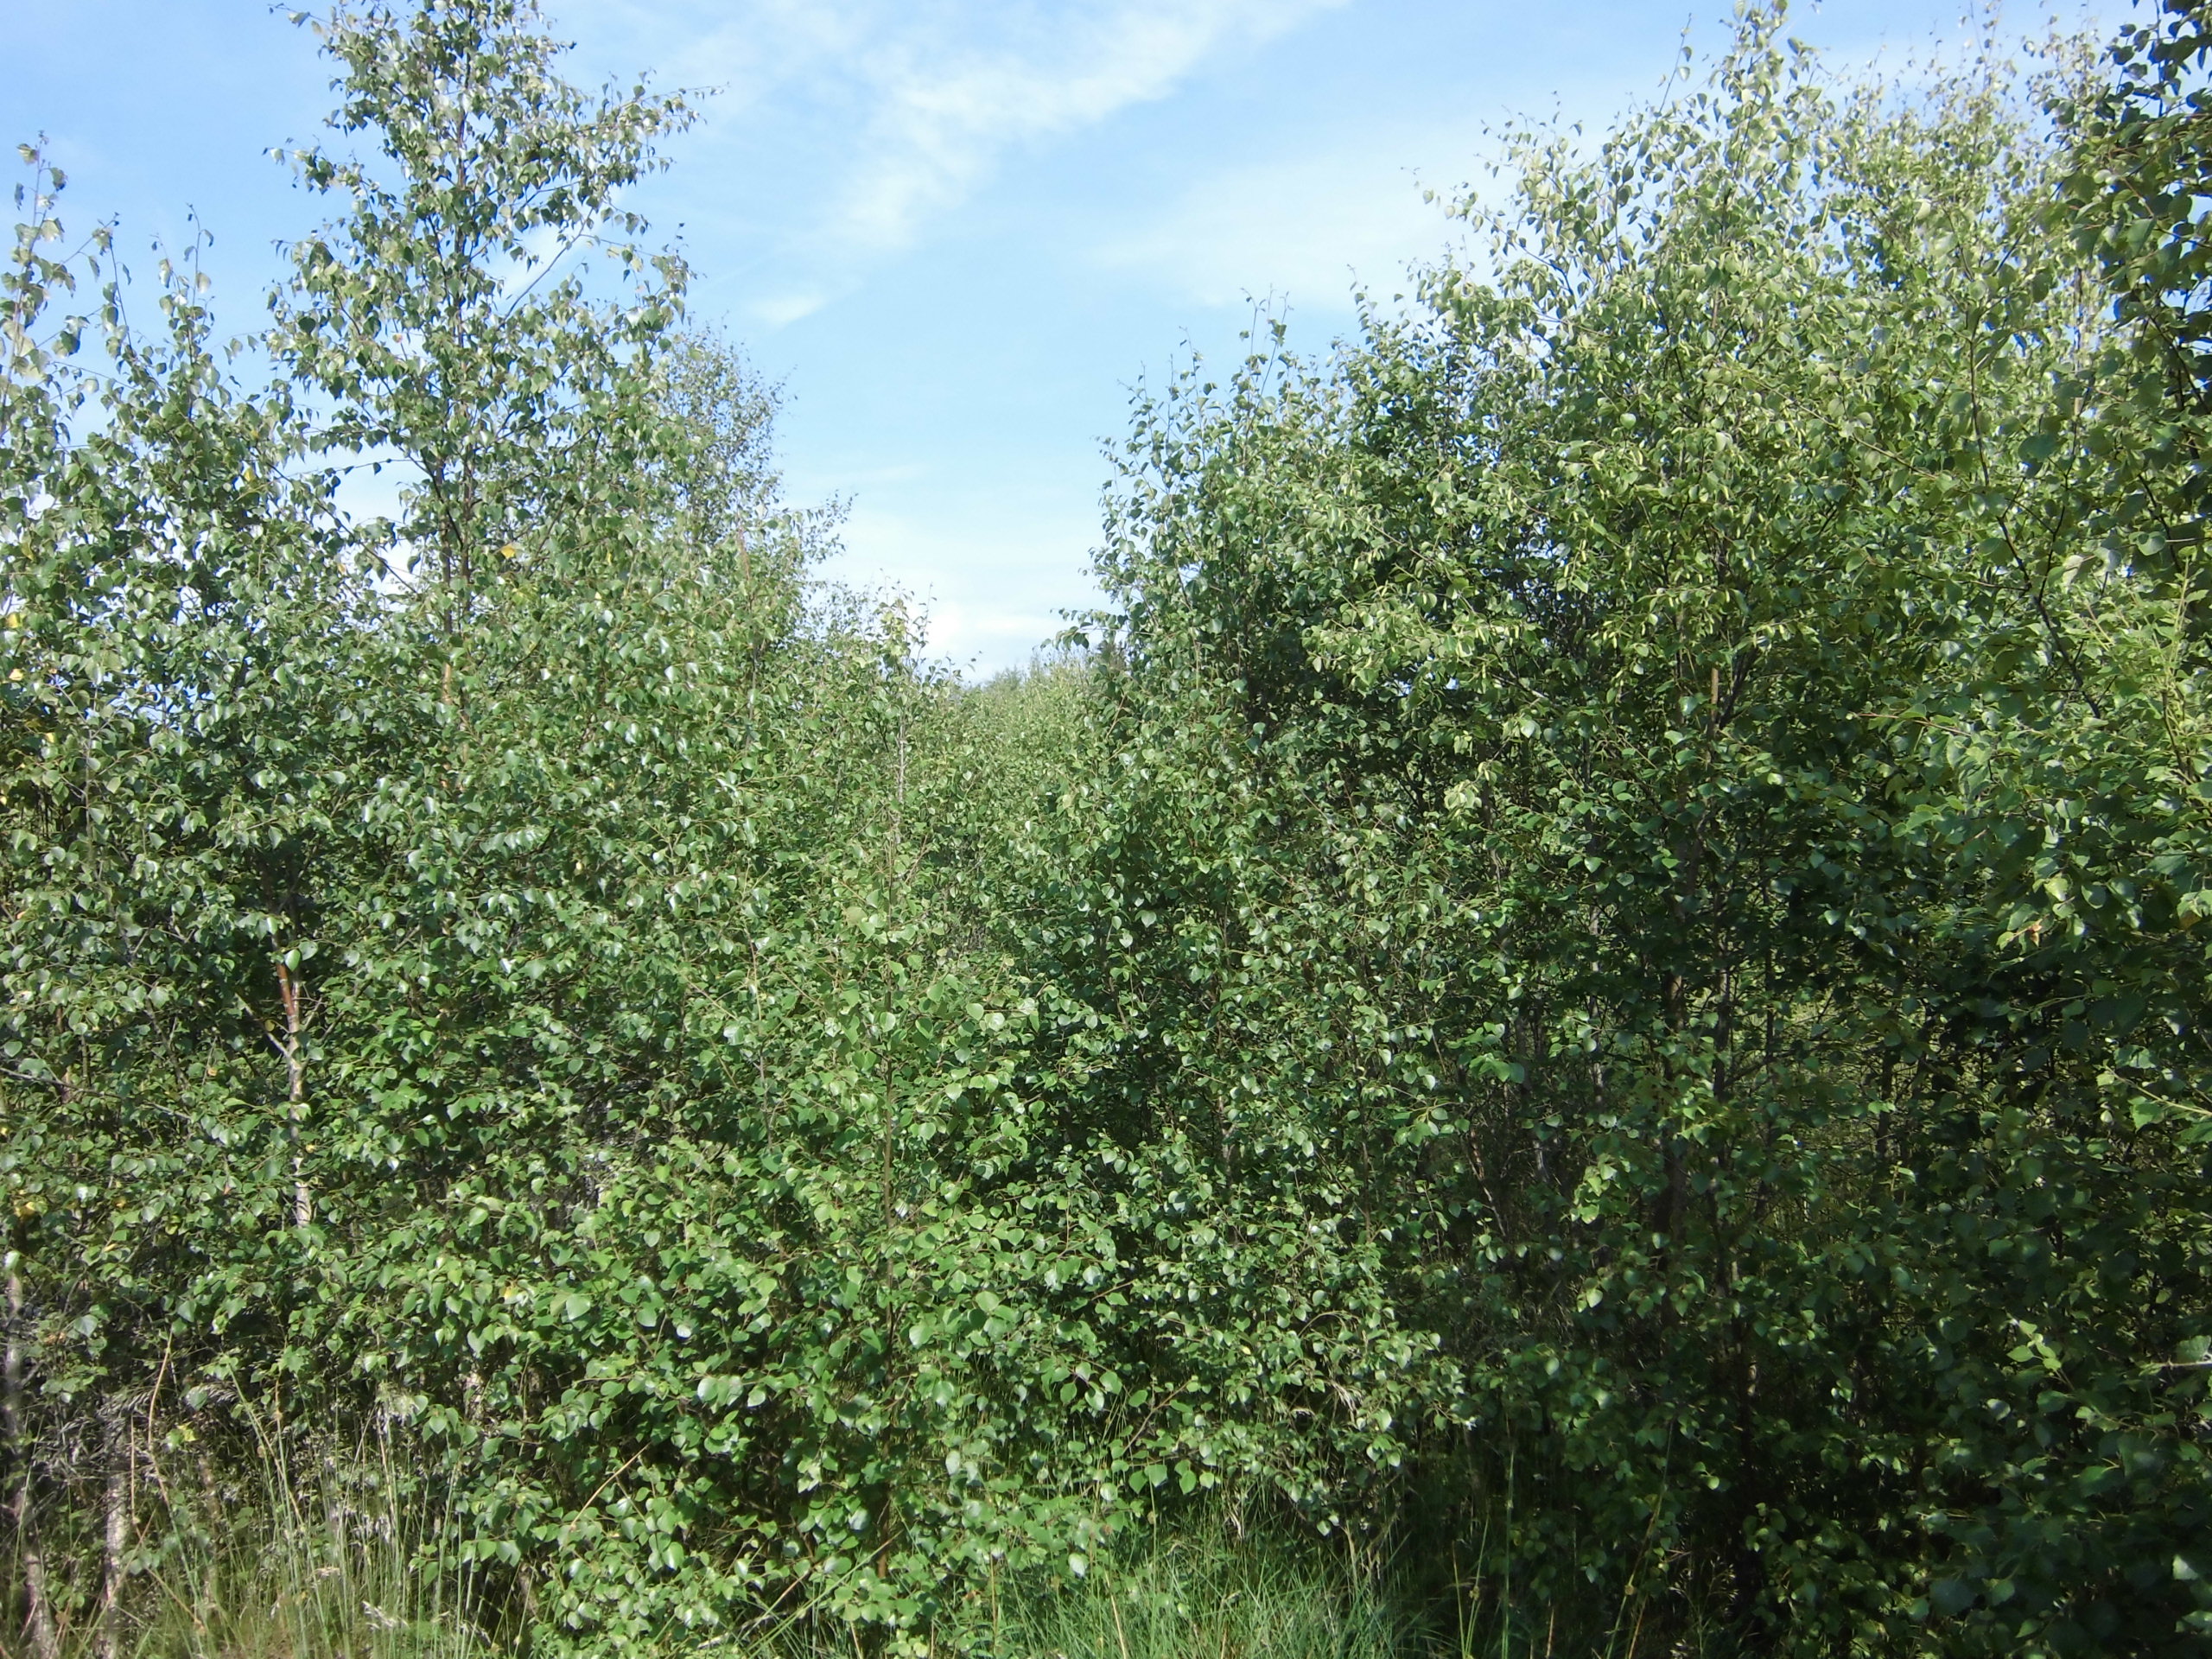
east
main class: Woodland
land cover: Spruce dominated mixed woodland
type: boreal forest
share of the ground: > 75 %
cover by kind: broadleaved forest trees 45 %, coniferous forest trees 30 %, herbaceous plants 15 %, shrubs 5 %, lichens and mosses 5 %
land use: Forestry
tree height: < 5 m
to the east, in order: Spruce dominated mixed woodland; Broadleaved woodland; Spruce dominated mixed woodland; Ditches and canals; Spruce dominated mixed woodland; Tracks; Fences; Spruce dominated mixed woodland; Pine dominated mixed woodland; Artificial constructions; Broadleaved woodland
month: July
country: SE
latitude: 57.3493
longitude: 14.5662
